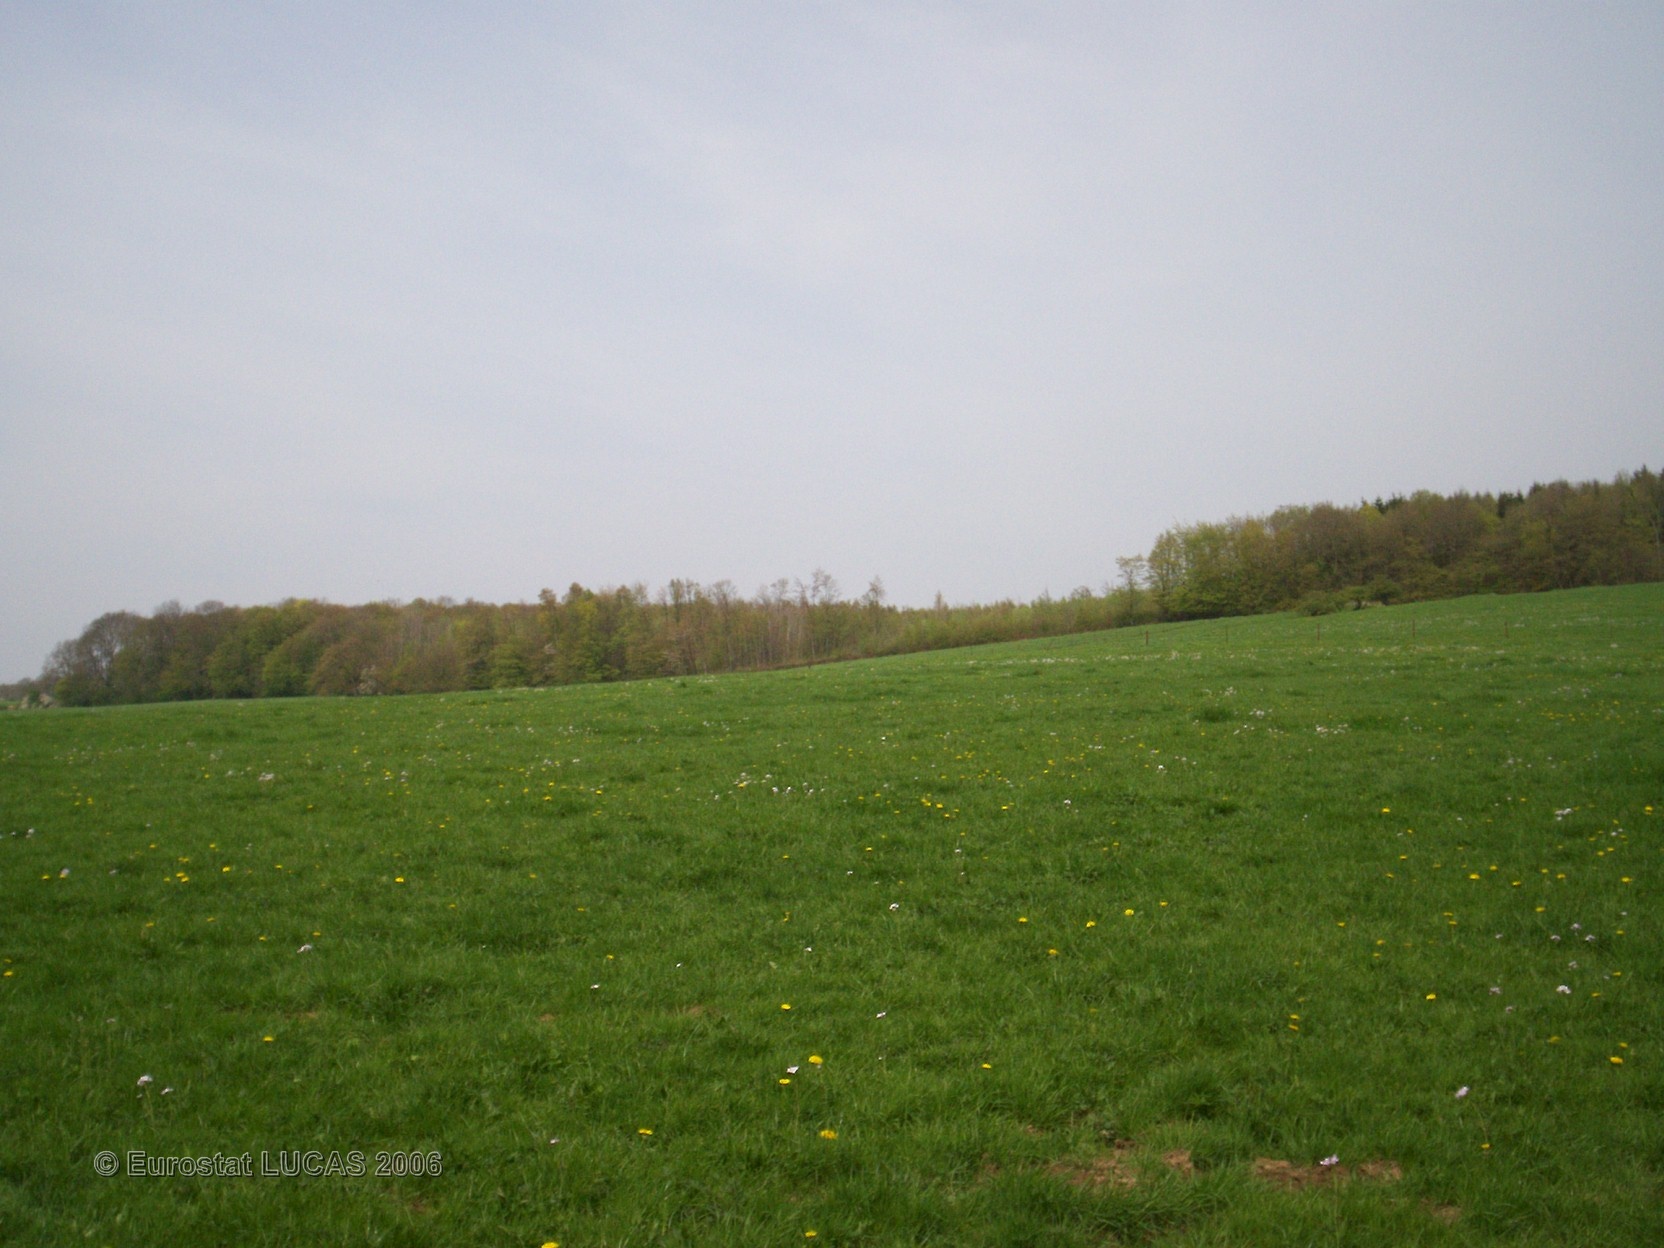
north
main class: Grassland
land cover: Grassland without tree/shrub cover
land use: Agriculture (excluding fallow land and kitchen gardens)
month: May
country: FR
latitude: 49.8824
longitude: 4.3592
